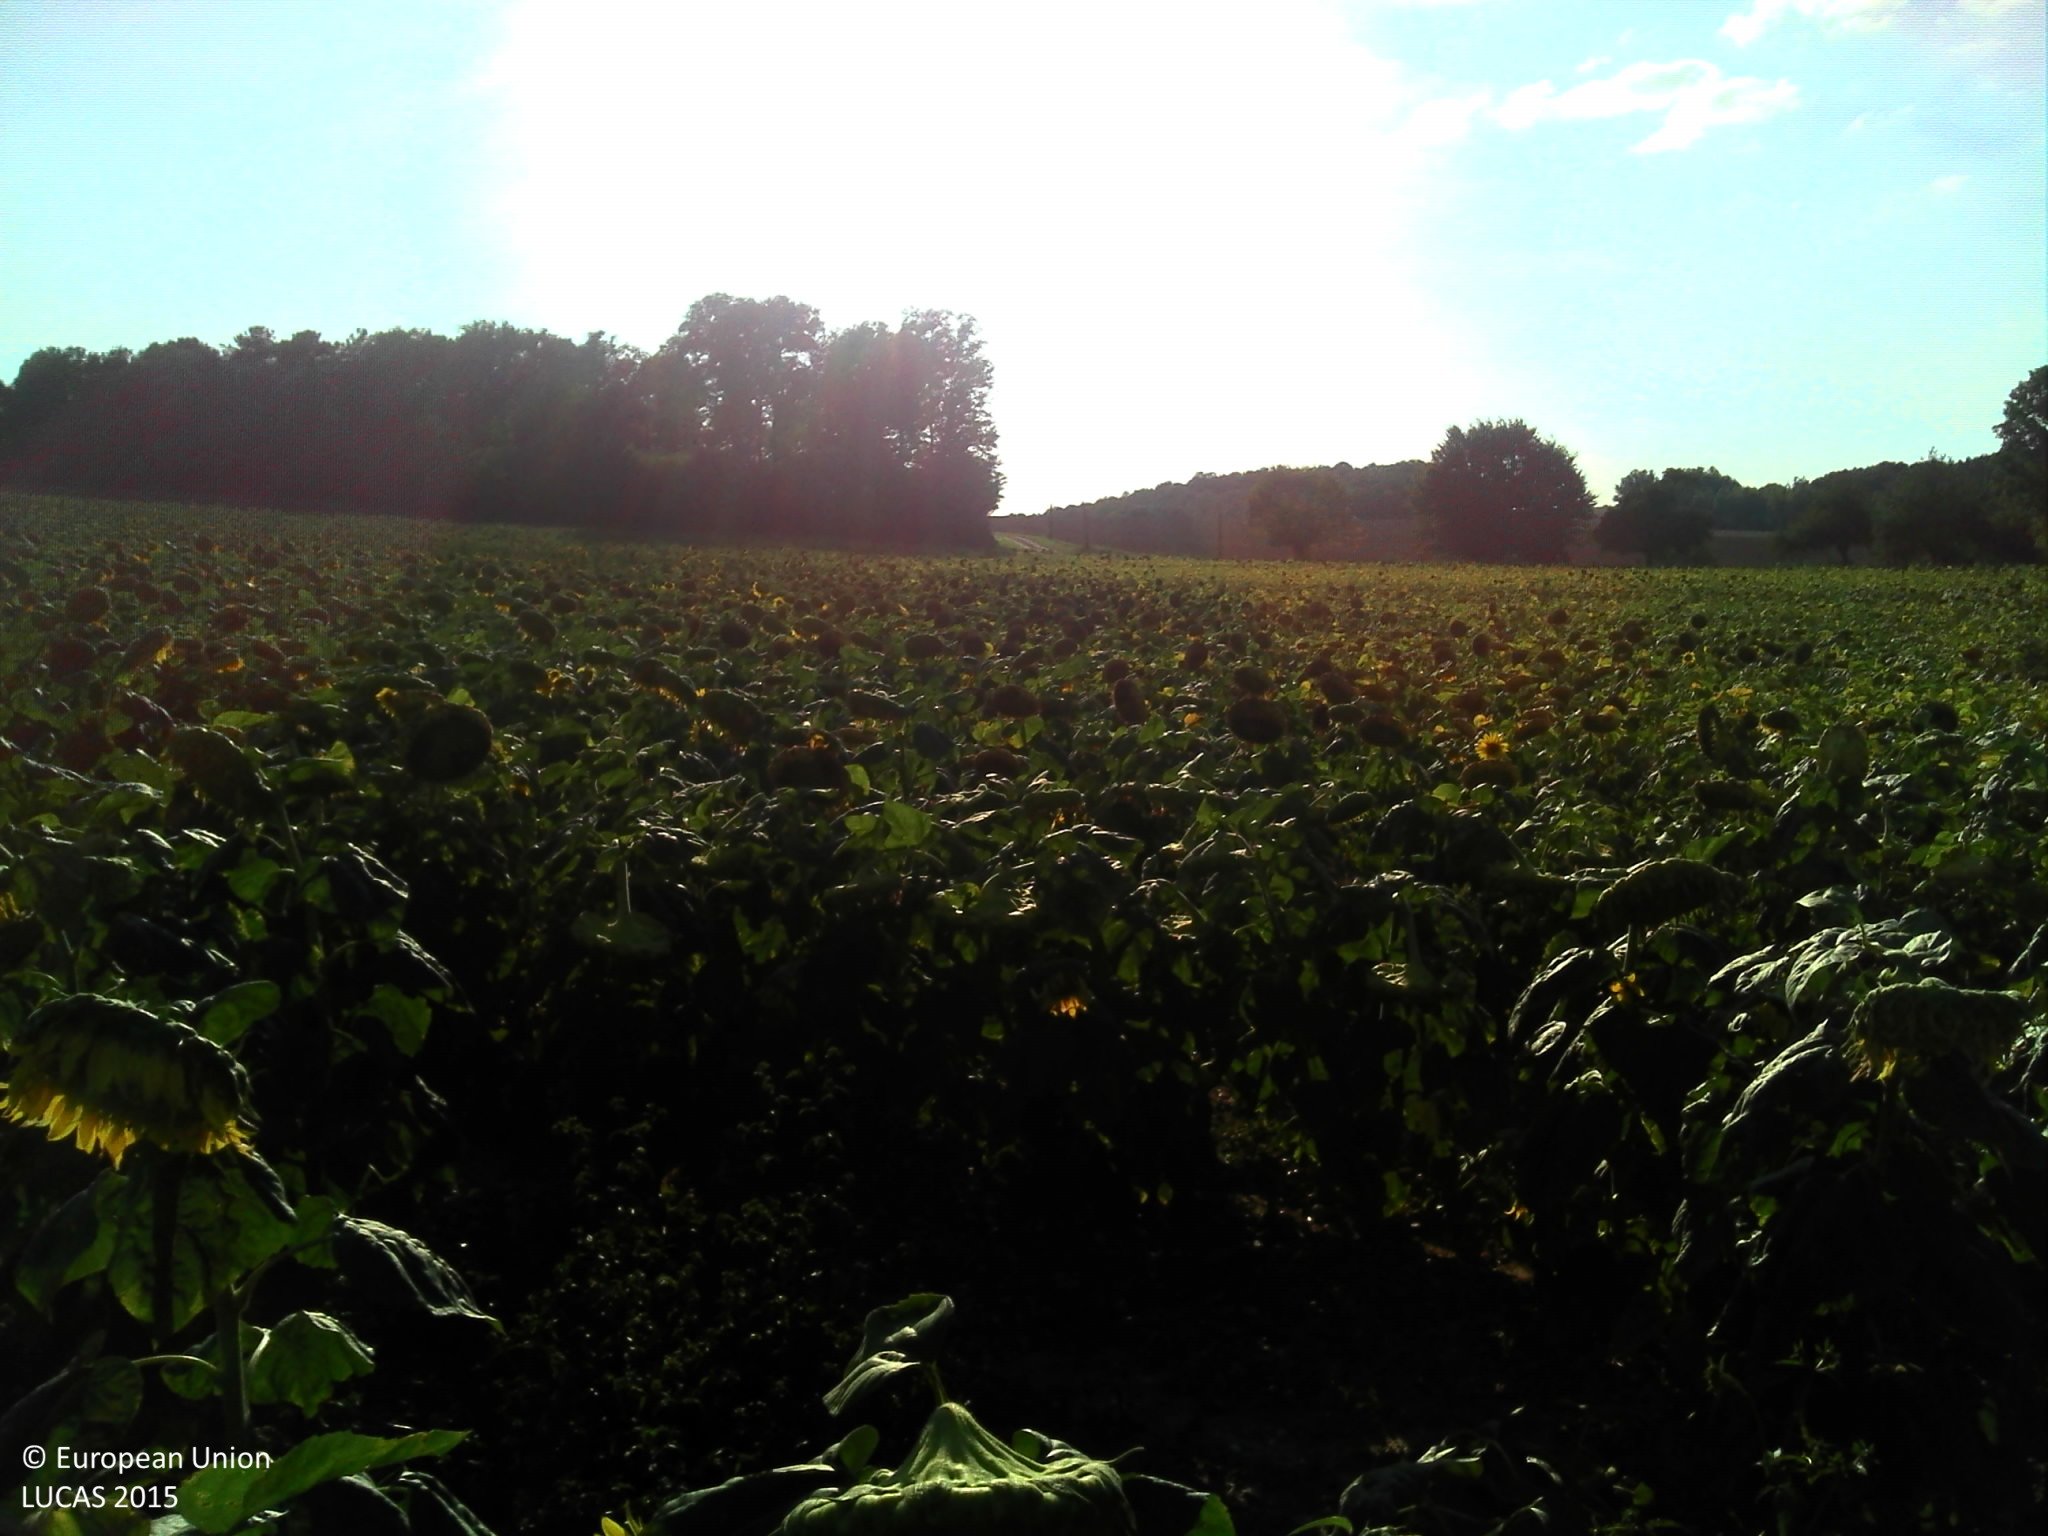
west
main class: Cropland
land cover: Sunflower
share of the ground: > 75 %
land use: Agriculture (excluding fallow land and kitchen gardens)
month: September
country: FR
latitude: 47.0442
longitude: 1.4982
